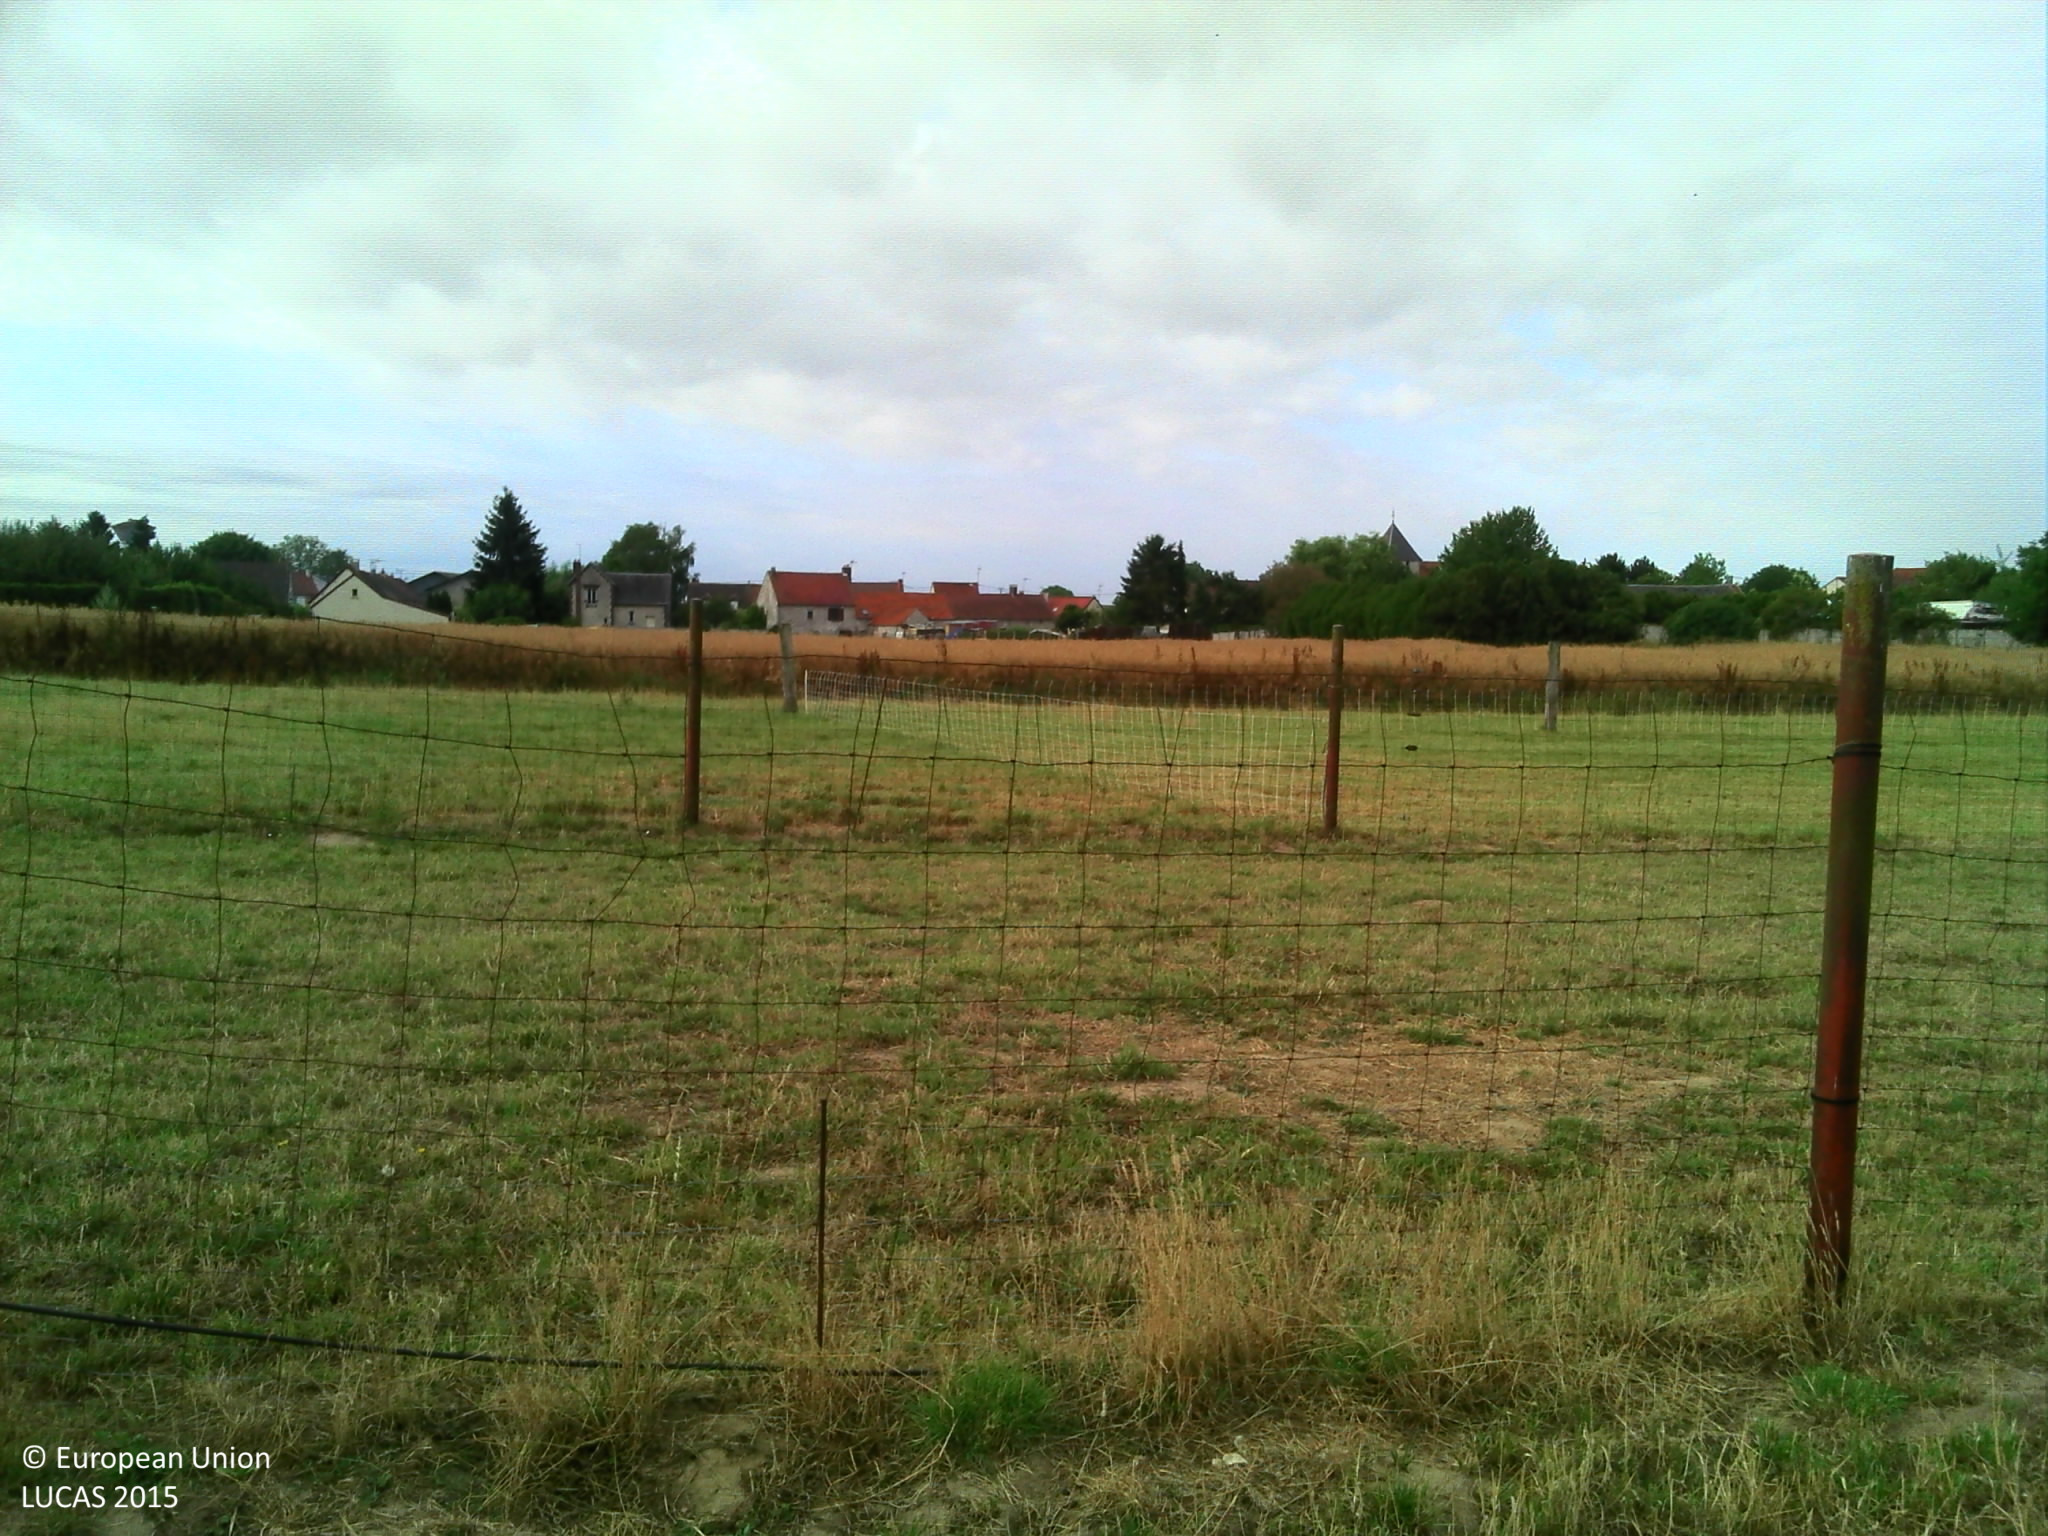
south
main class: Grassland
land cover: Grassland without tree/shrub cover
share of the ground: > 75 %
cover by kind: herbaceous plants 100 %
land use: Agriculture (excluding fallow land and kitchen gardens)
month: July
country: FR
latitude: 49.1666
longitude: 2.8723
